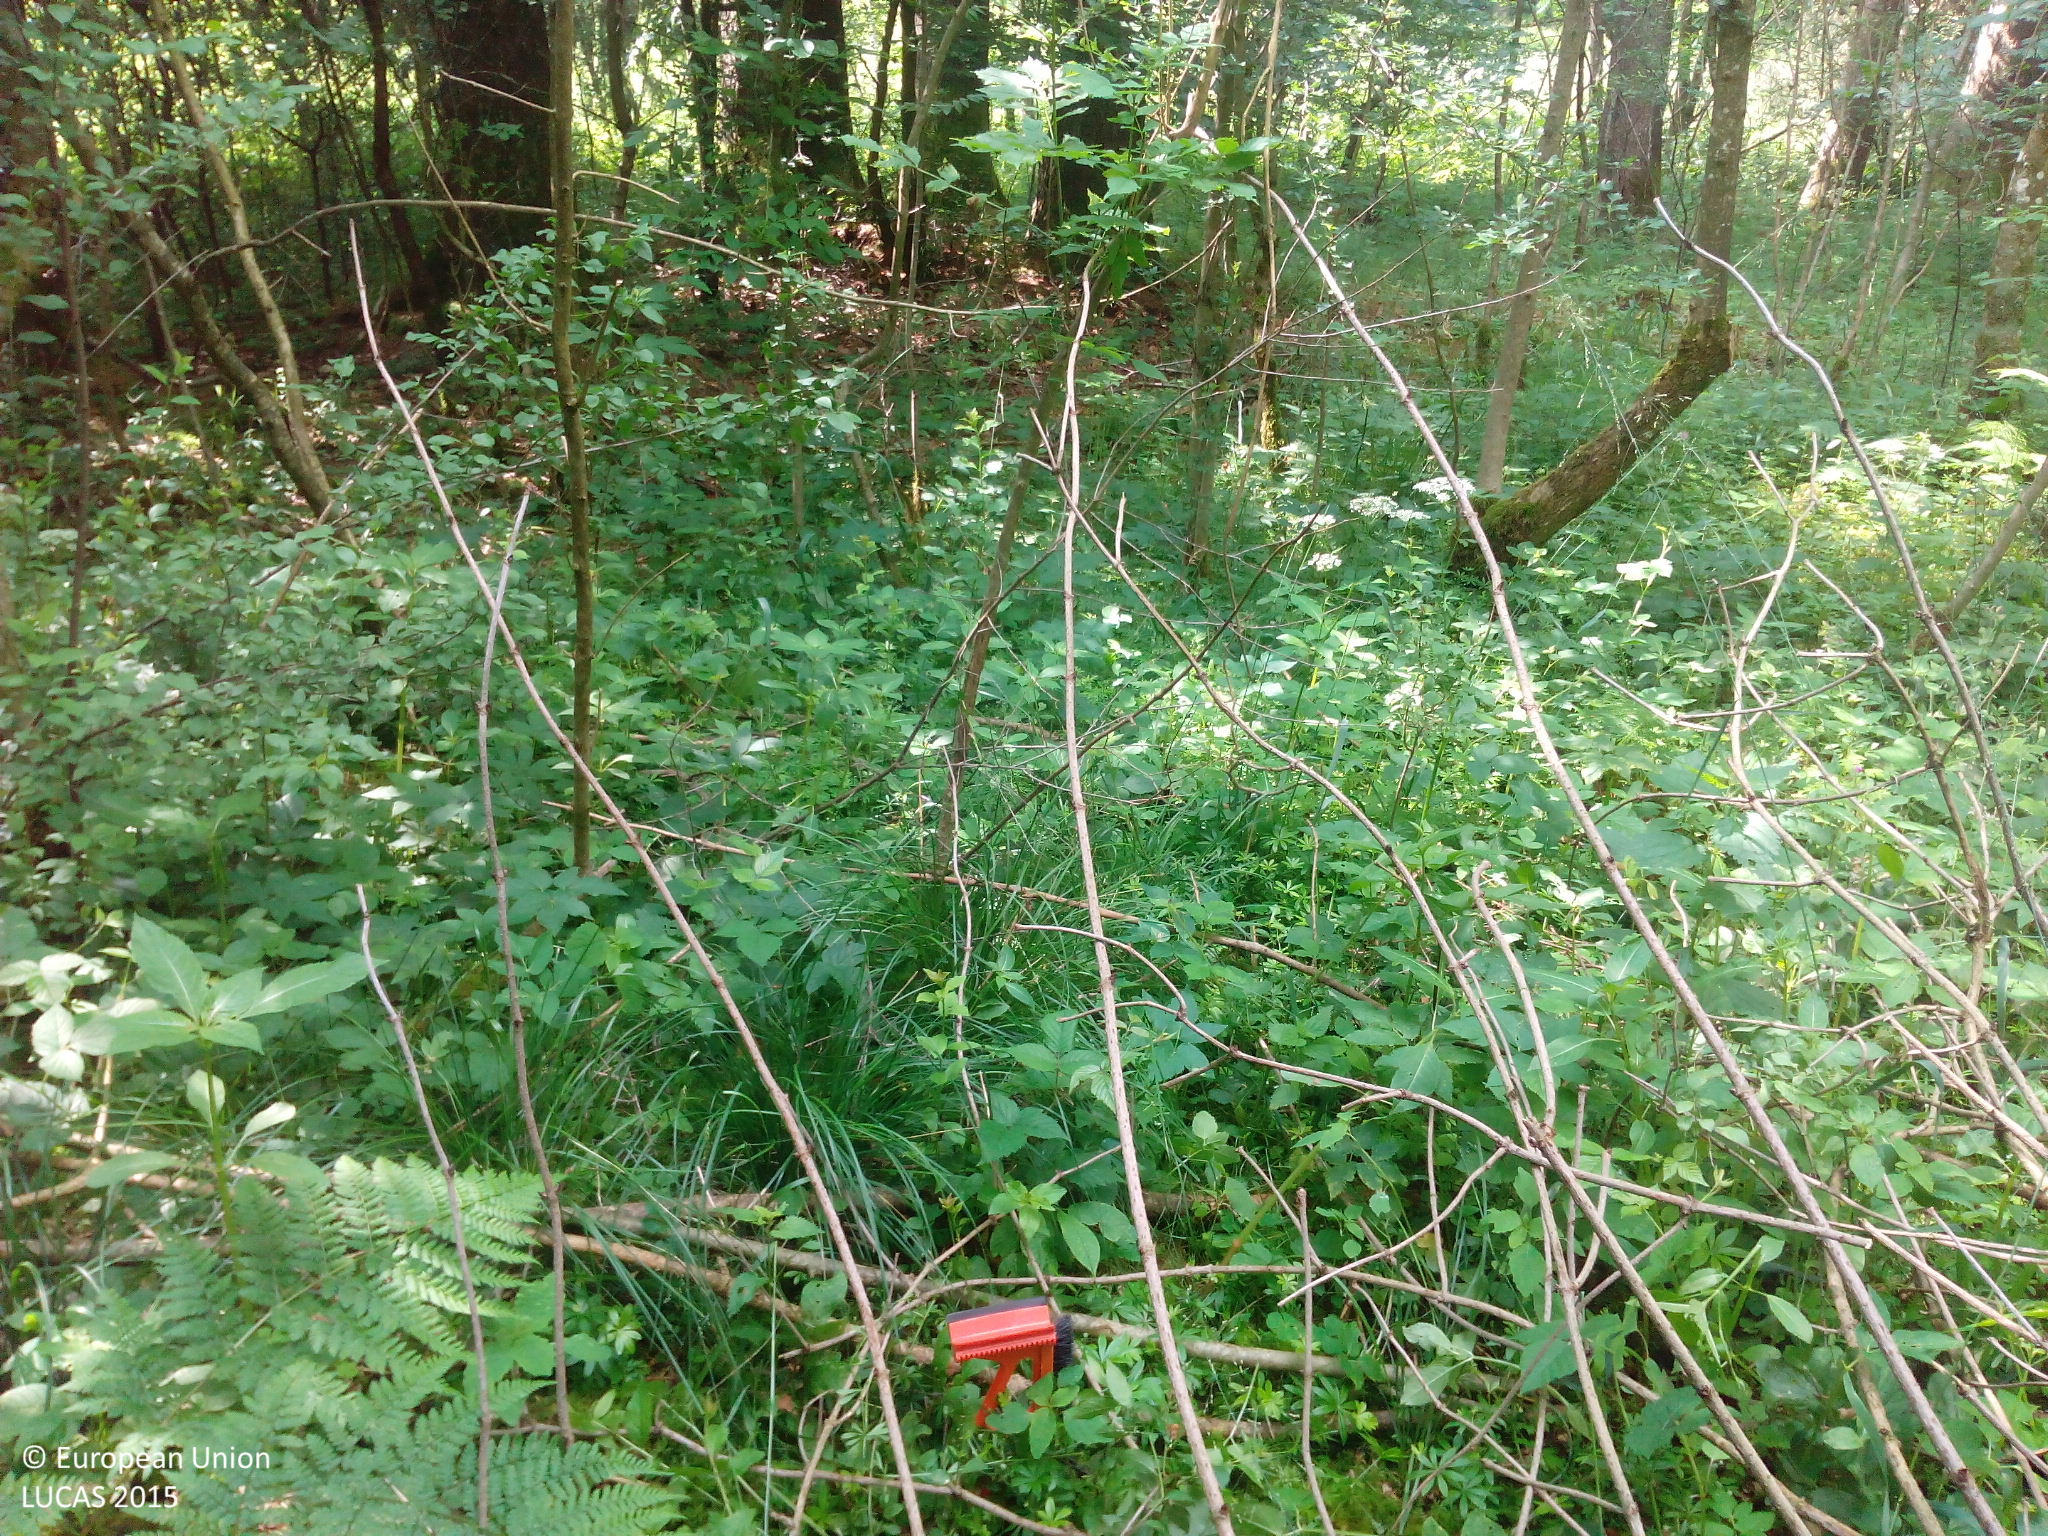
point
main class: Woodland
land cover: Other mixed woodland
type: hemiboreal forest and nemoral coniferous forest and mixed broadleaved-coniferous forest
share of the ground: > 75 %
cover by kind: broadleaved forest trees 55 %, coniferous forest trees 25 %, shrubs 10 %, herbaceous plants 10 %
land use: Forestry
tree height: > 5 m
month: June
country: DE
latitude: 47.7196
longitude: 9.9334
